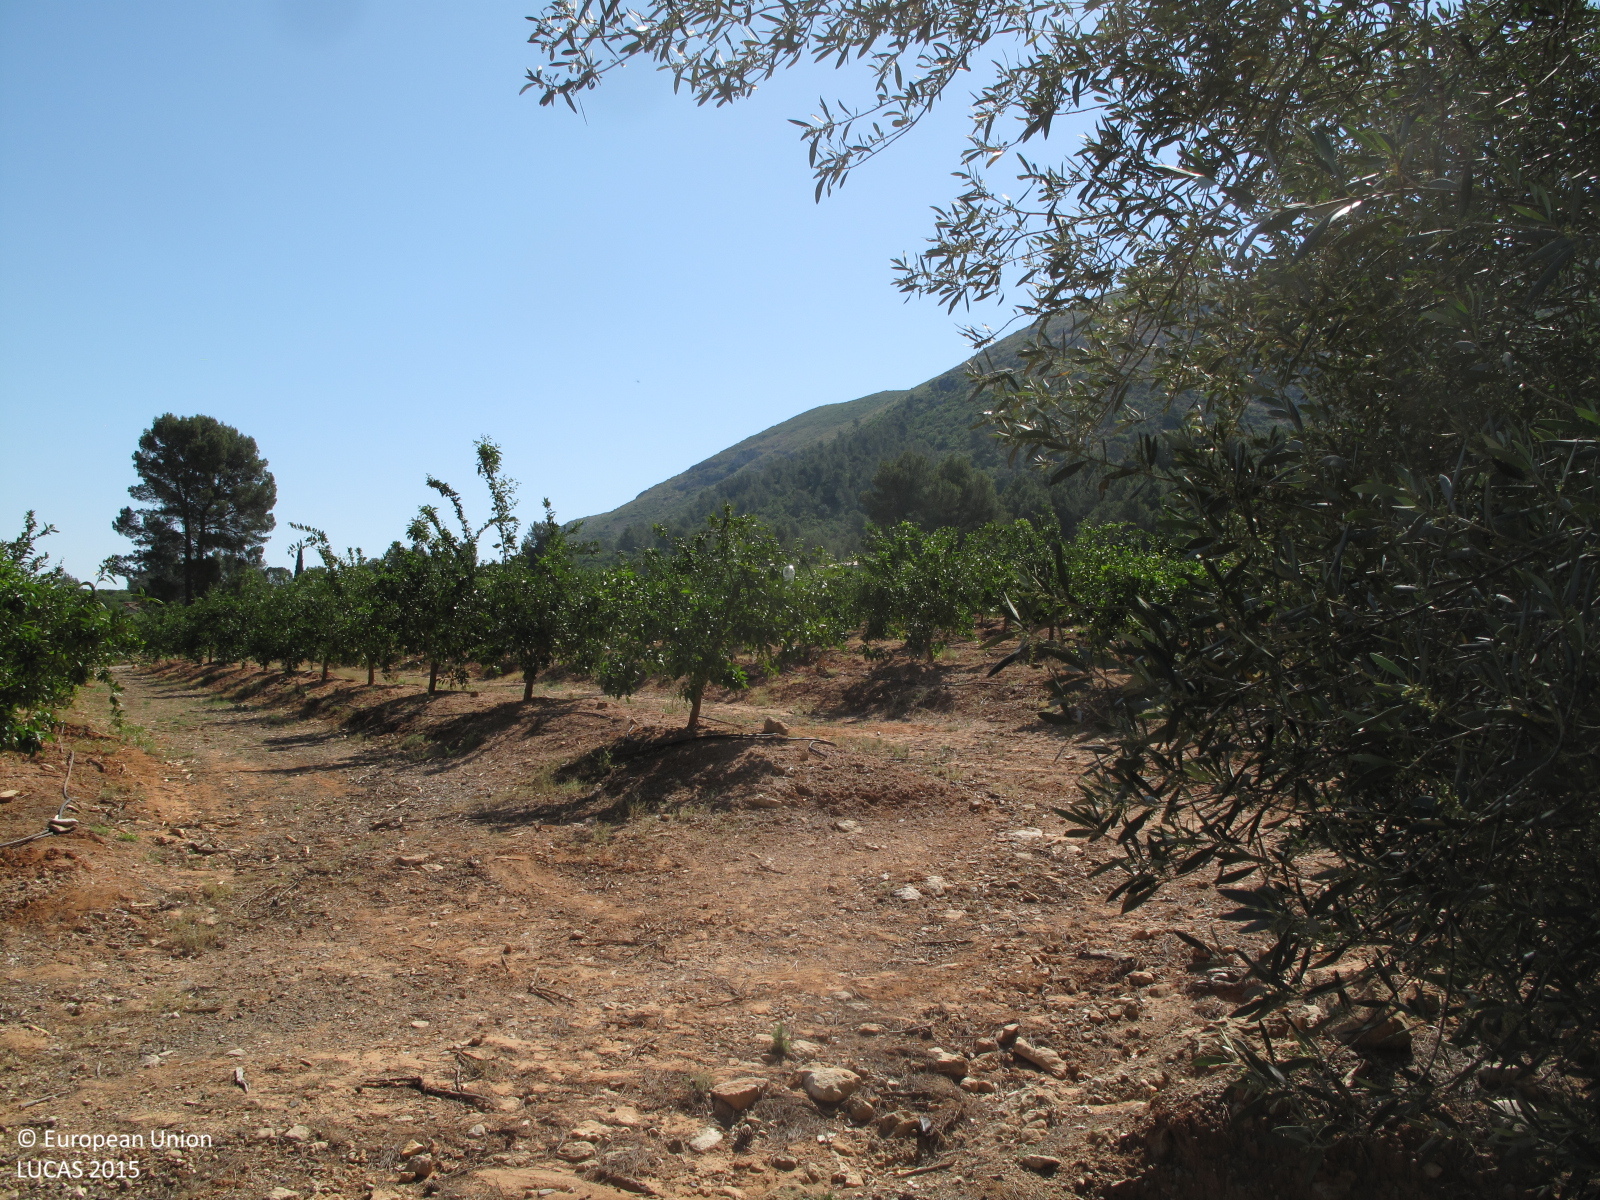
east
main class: Woodland
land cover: Pine dominated coniferous woodland
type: coniferous forest of the mediterranean region
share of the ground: > 75 %
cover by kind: coniferous forest trees 90 %, shrubs 10 %
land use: Semi-natural and natural areas not in use
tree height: > 5 m
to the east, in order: Pine dominated coniferous woodland; Tracks; Oranges; Tracks; Oranges; Tracks; Shrubland with sparse tree cover; Tracks; Shruby margins; Groves; Dry stone walls; Grassland without tree/shrub cover; Artificial constructions in urban areas; Dry stone walls; Spontaneously vegetated surfaces; Olive groves; Single bushes/trees; Shruby margins
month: May
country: ES
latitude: 38.9489
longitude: -0.5500
